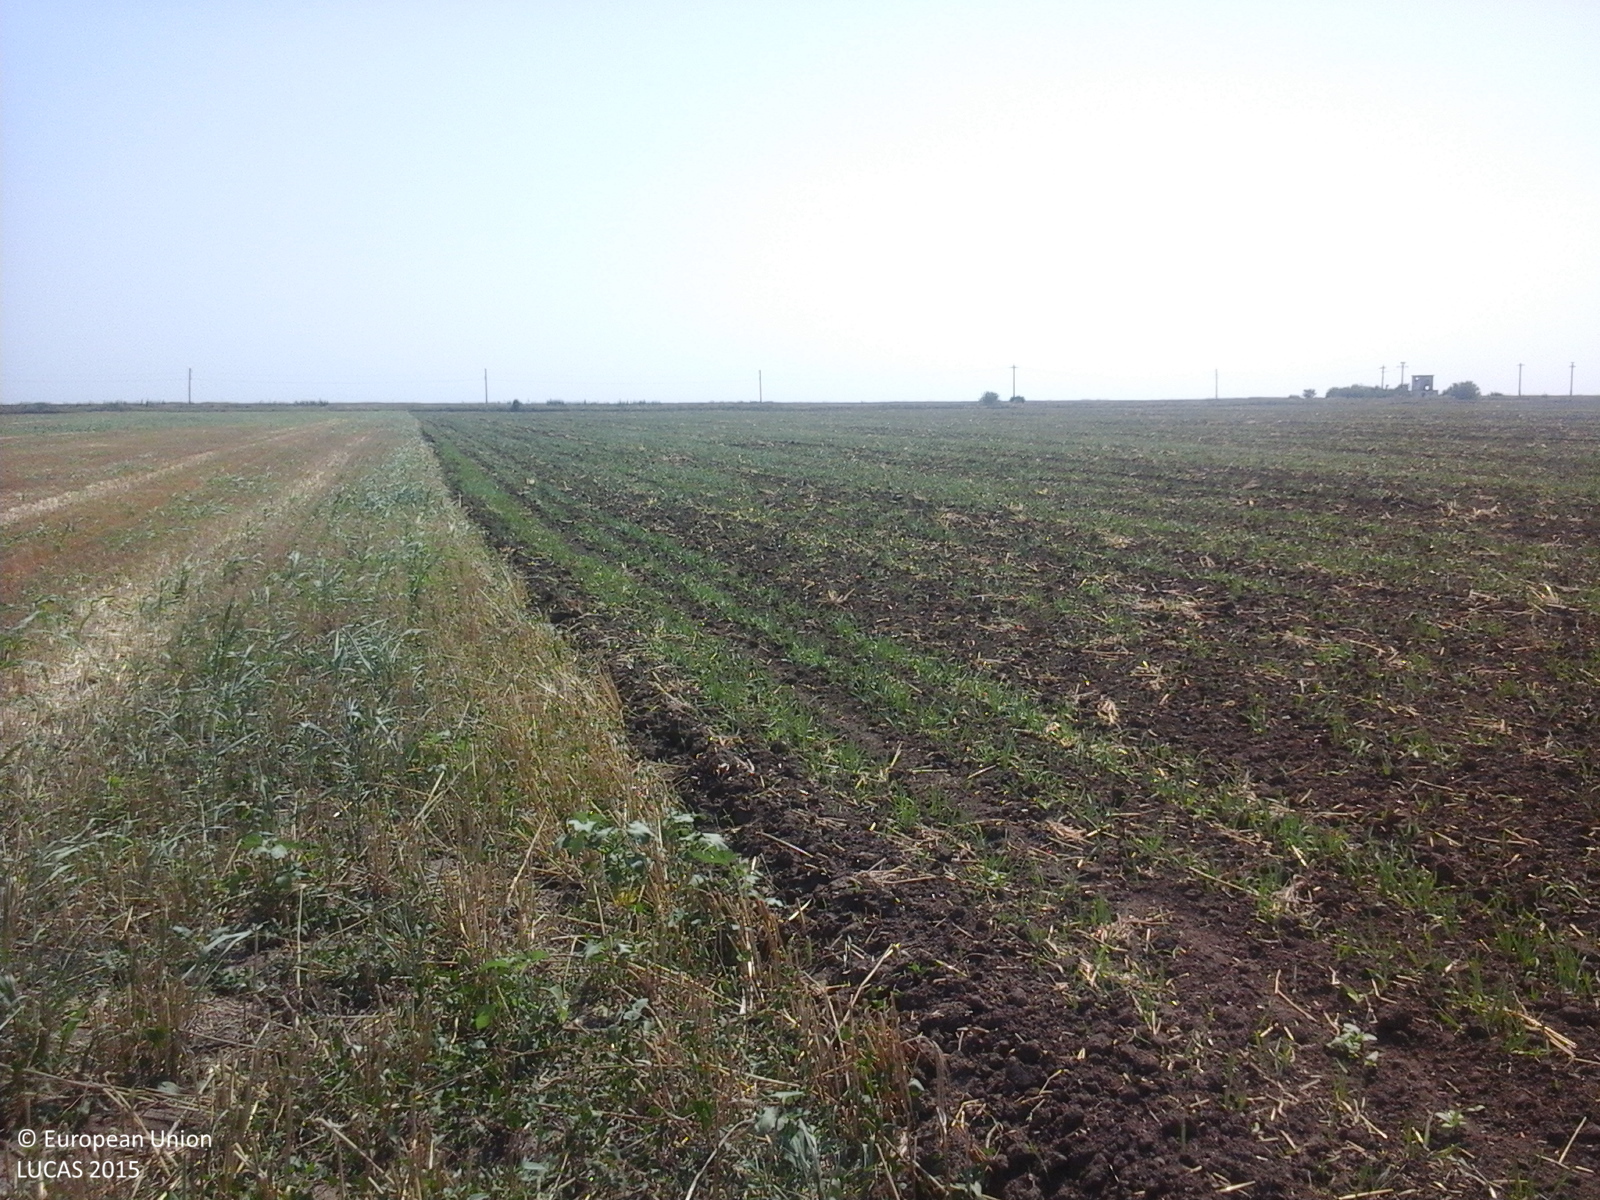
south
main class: Cropland
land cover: Common wheat
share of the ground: 25 - 50 %
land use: Agriculture (excluding fallow land and kitchen gardens)
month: July
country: RO
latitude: 44.7071
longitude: 27.1883
